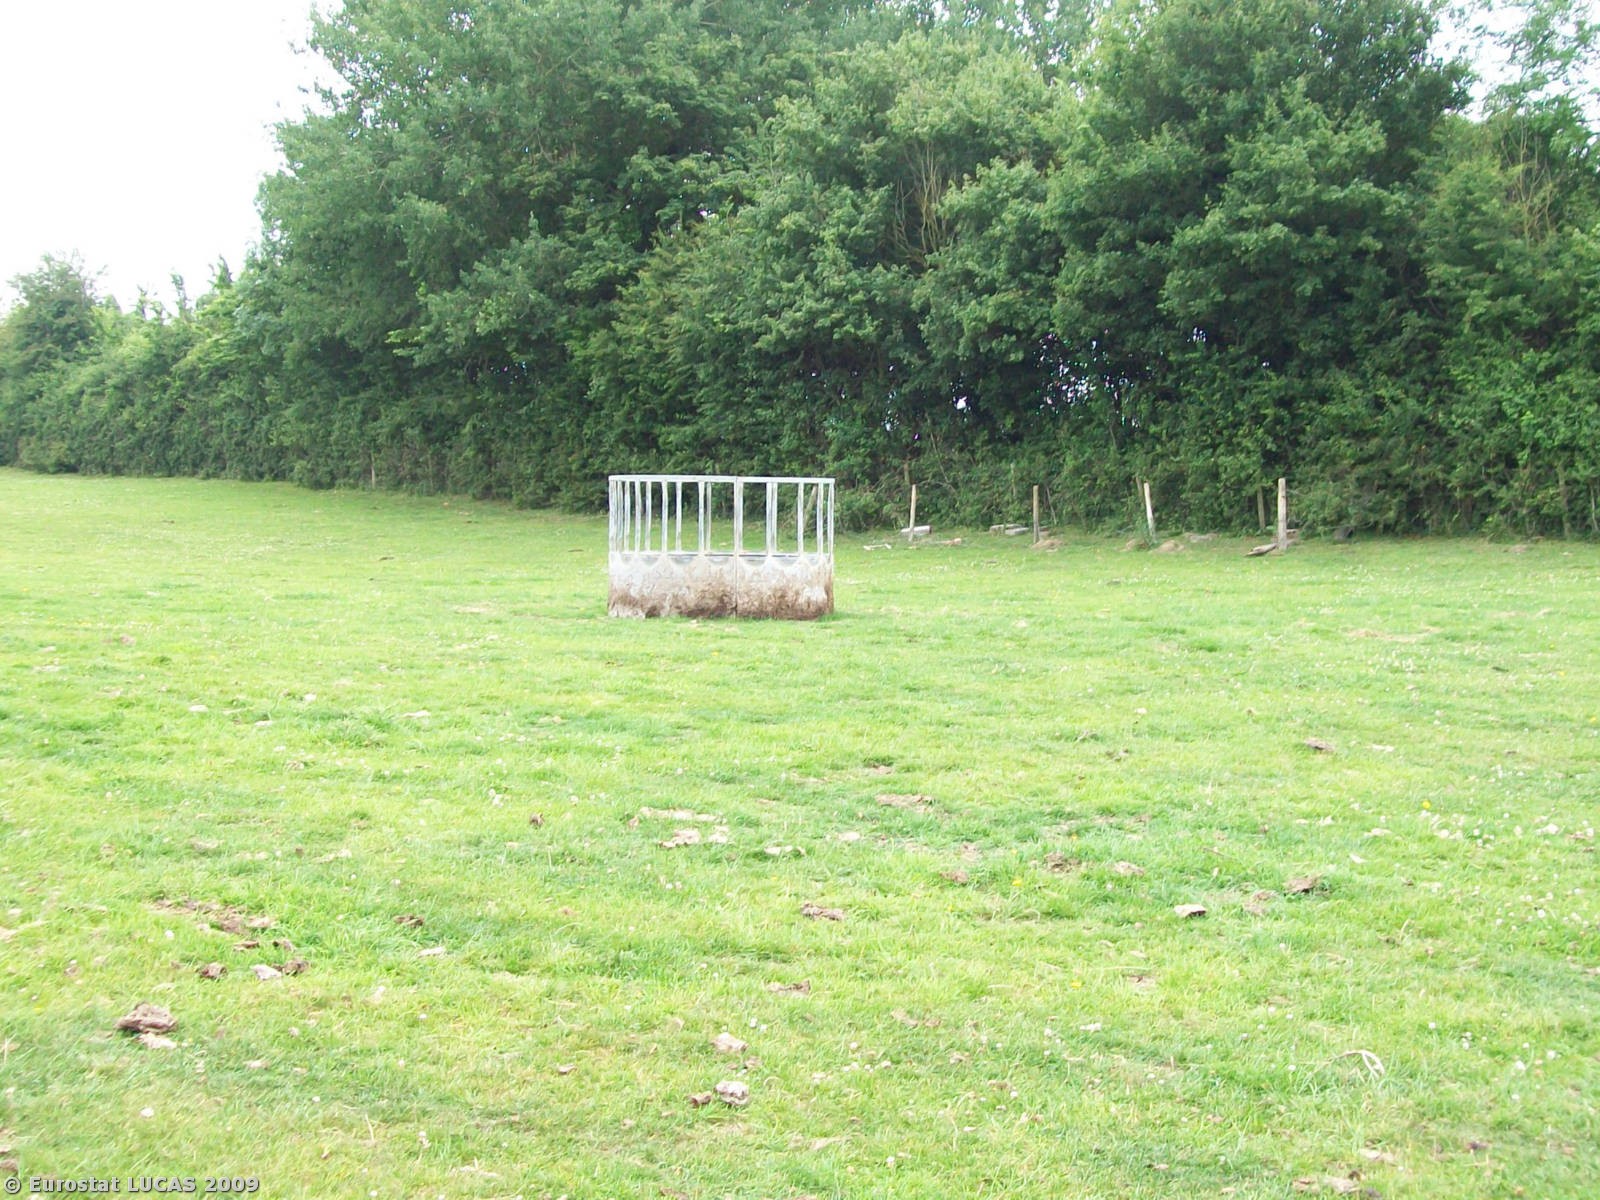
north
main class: Grassland
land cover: Grassland without tree/shrub cover
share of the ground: > 75 %
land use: Agriculture (excluding fallow land and kitchen gardens)
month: June
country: GB
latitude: 51.3192
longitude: -2.2734
